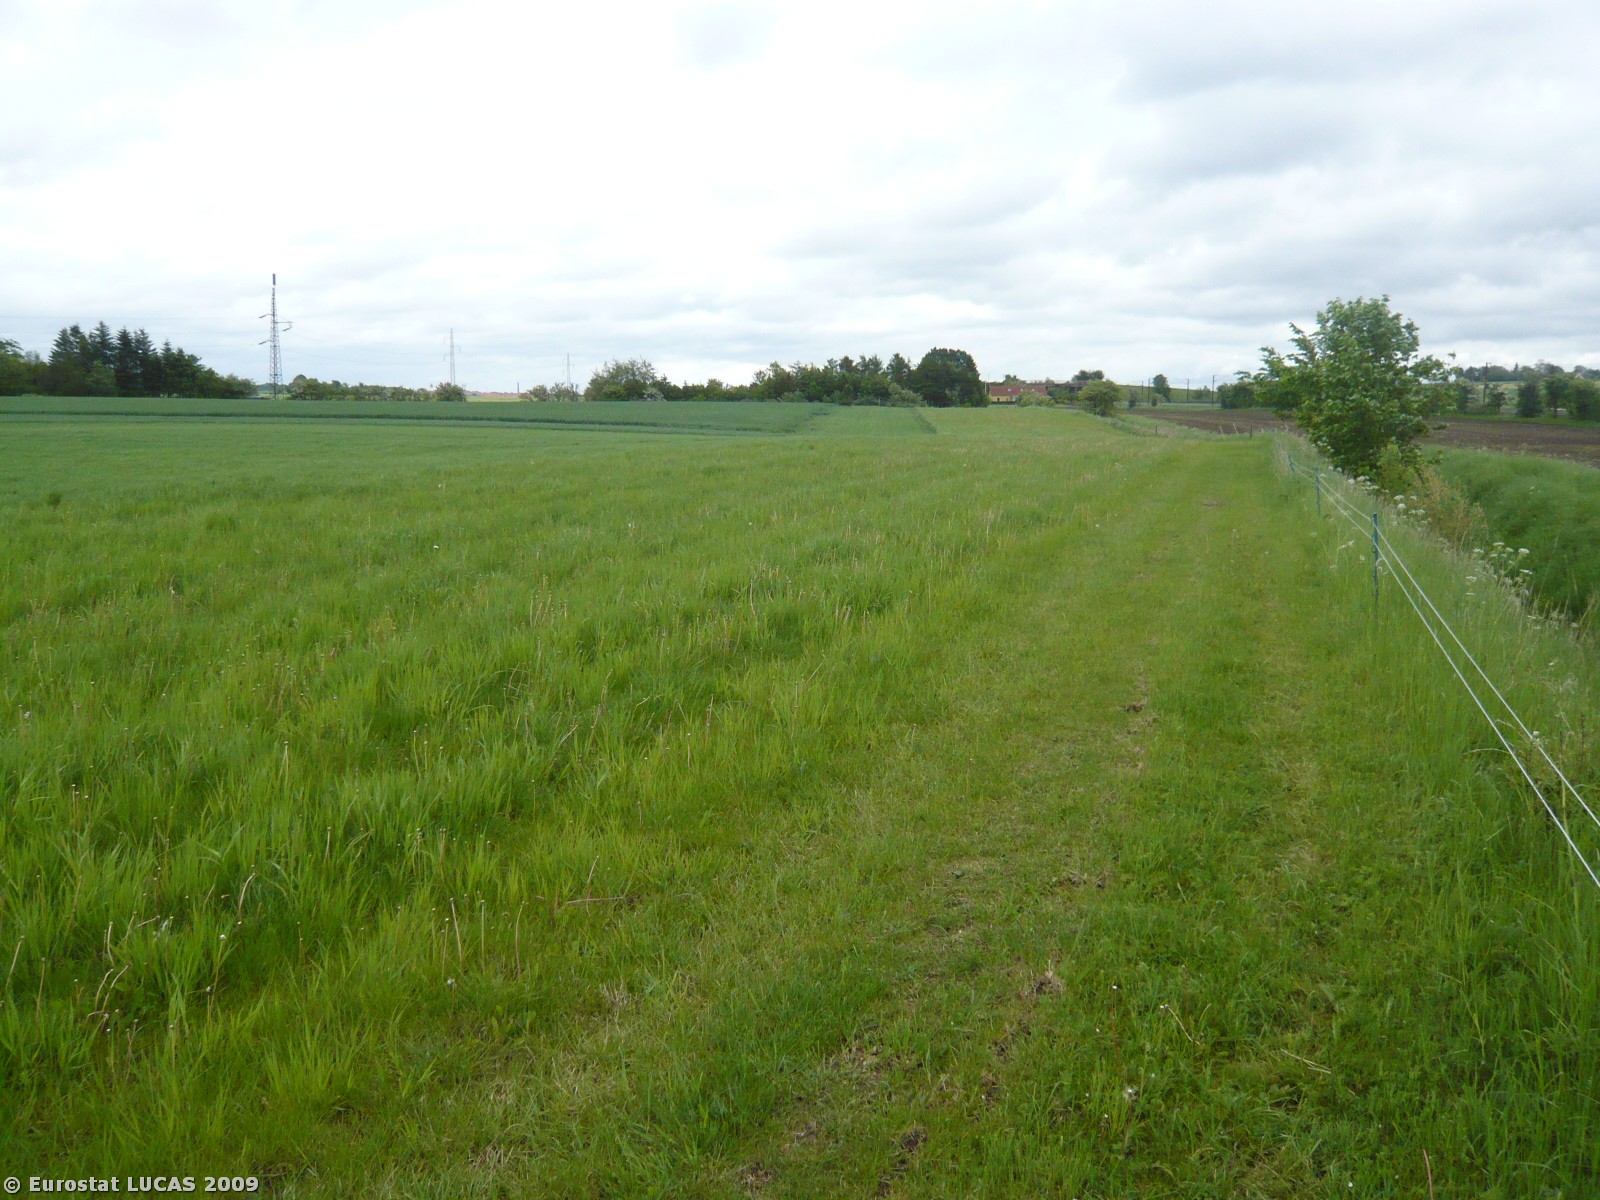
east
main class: Grassland
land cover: Grassland without tree/shrub cover
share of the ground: > 75 %
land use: Agriculture (excluding fallow land and kitchen gardens)
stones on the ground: < 10 %
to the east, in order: Grassland without tree/shrub cover; Barley; Rye; Common wheat; Fences; Grassland without tree/shrub cover
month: May
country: DK
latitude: 55.4391
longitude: 11.7214
